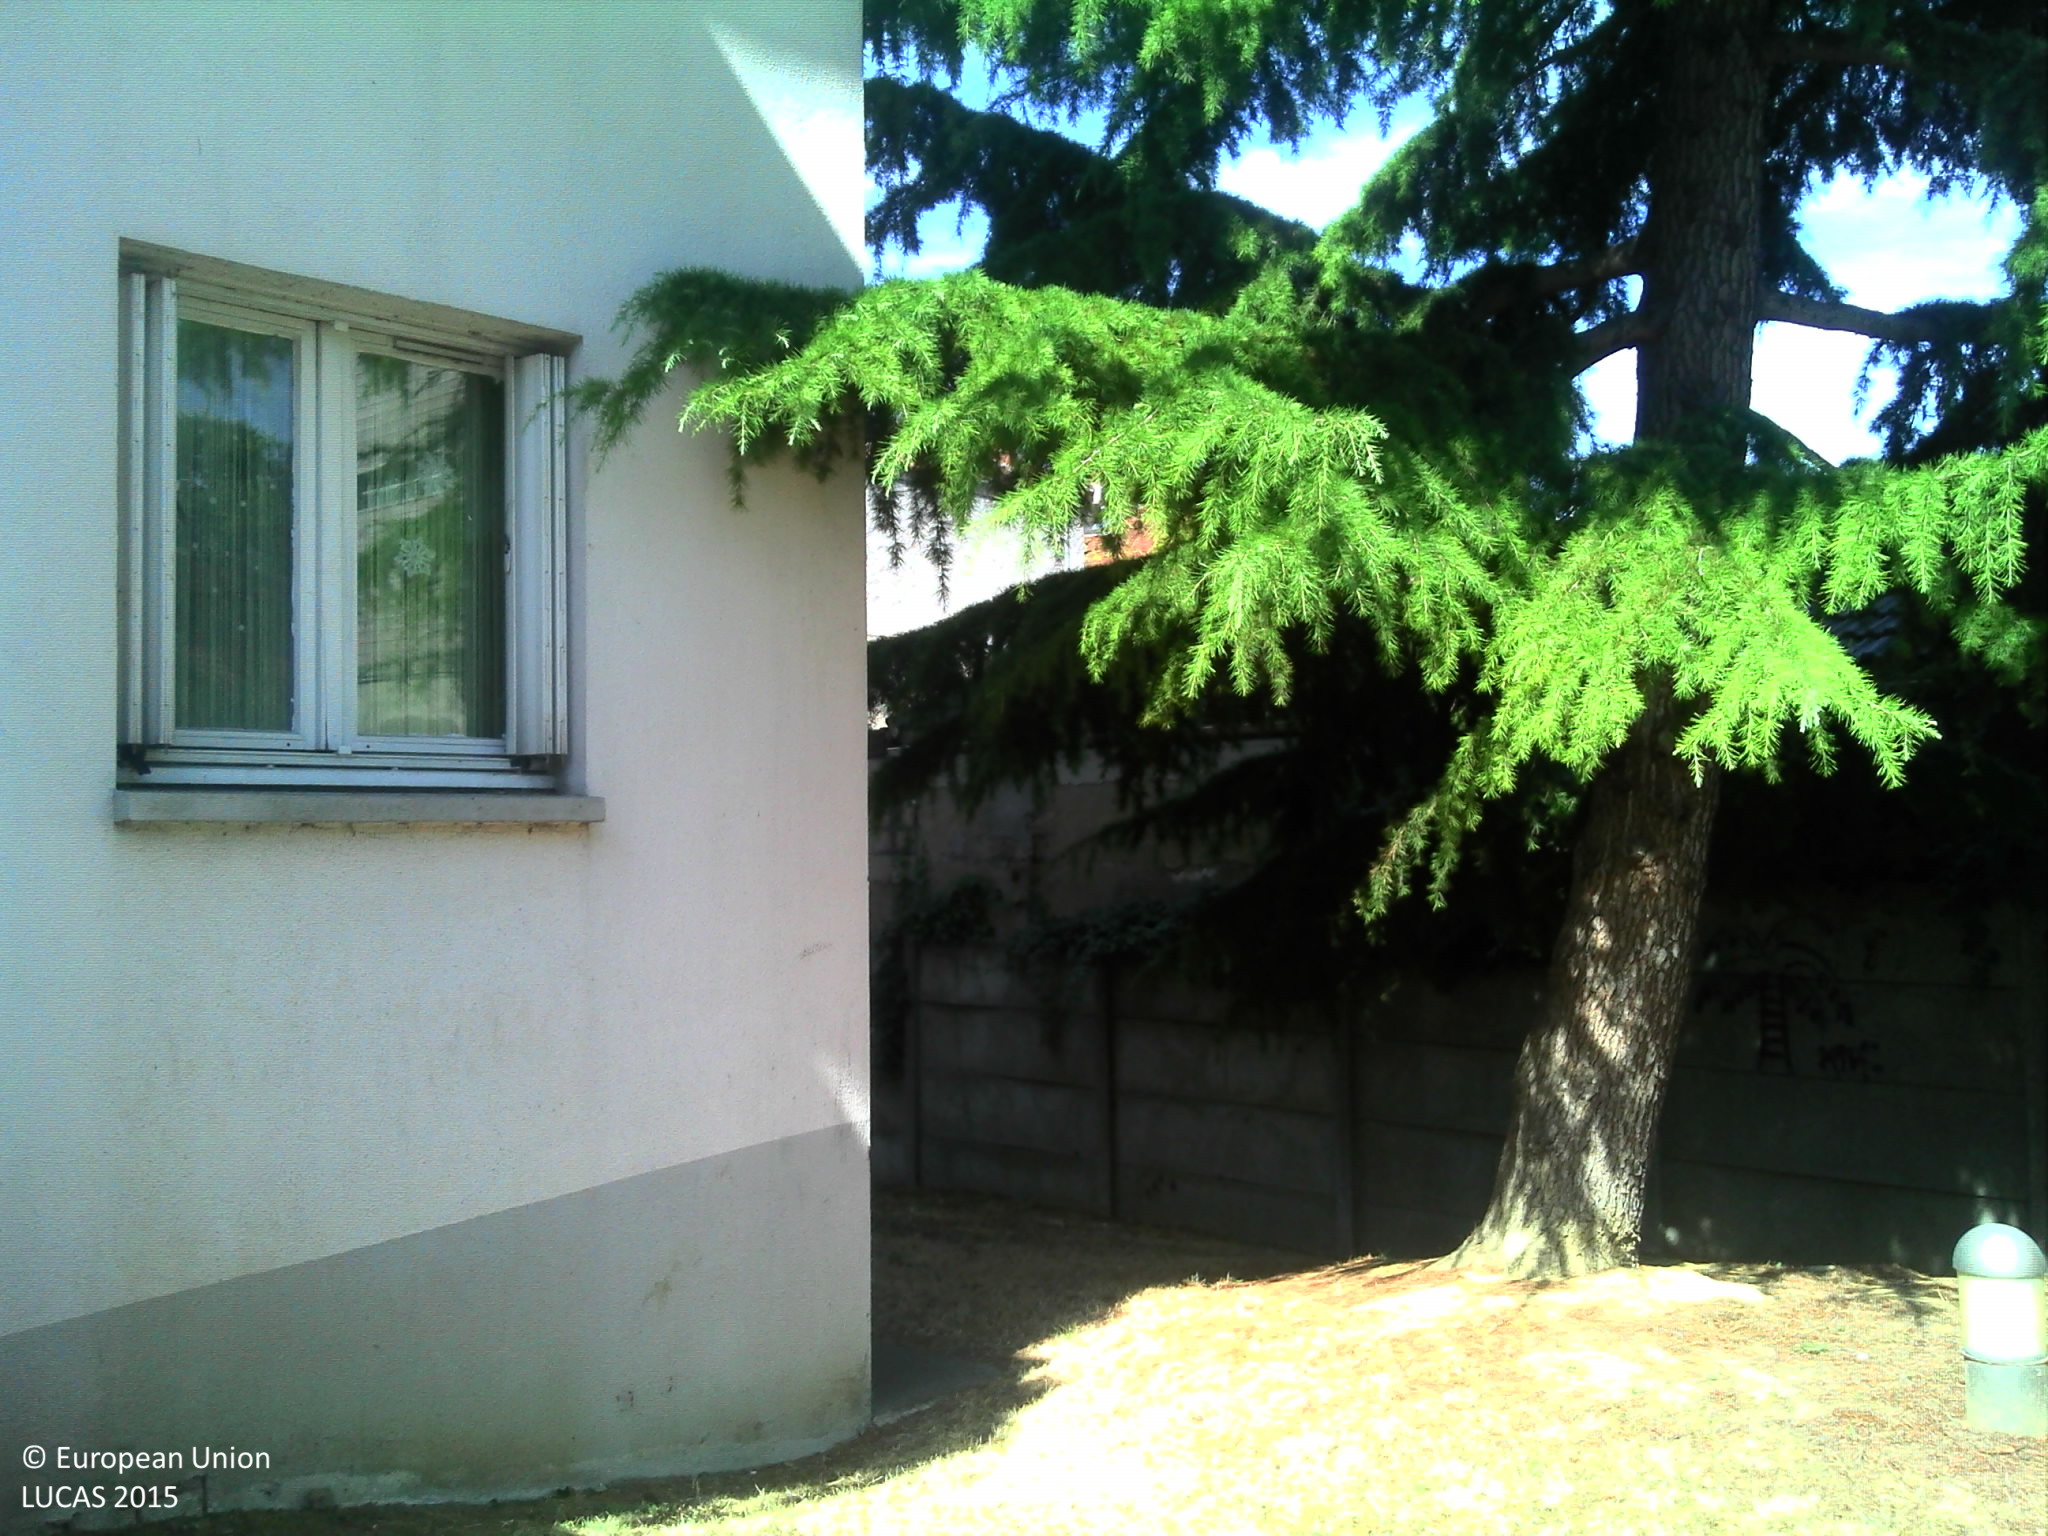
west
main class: Grassland
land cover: Grassland with sparse tree/shrub cover
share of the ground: > 75 %
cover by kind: herbaceous plants 95 %, broadleaved forest trees 5 %
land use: Road transport
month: August
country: FR
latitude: 48.8124
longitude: 2.4306
